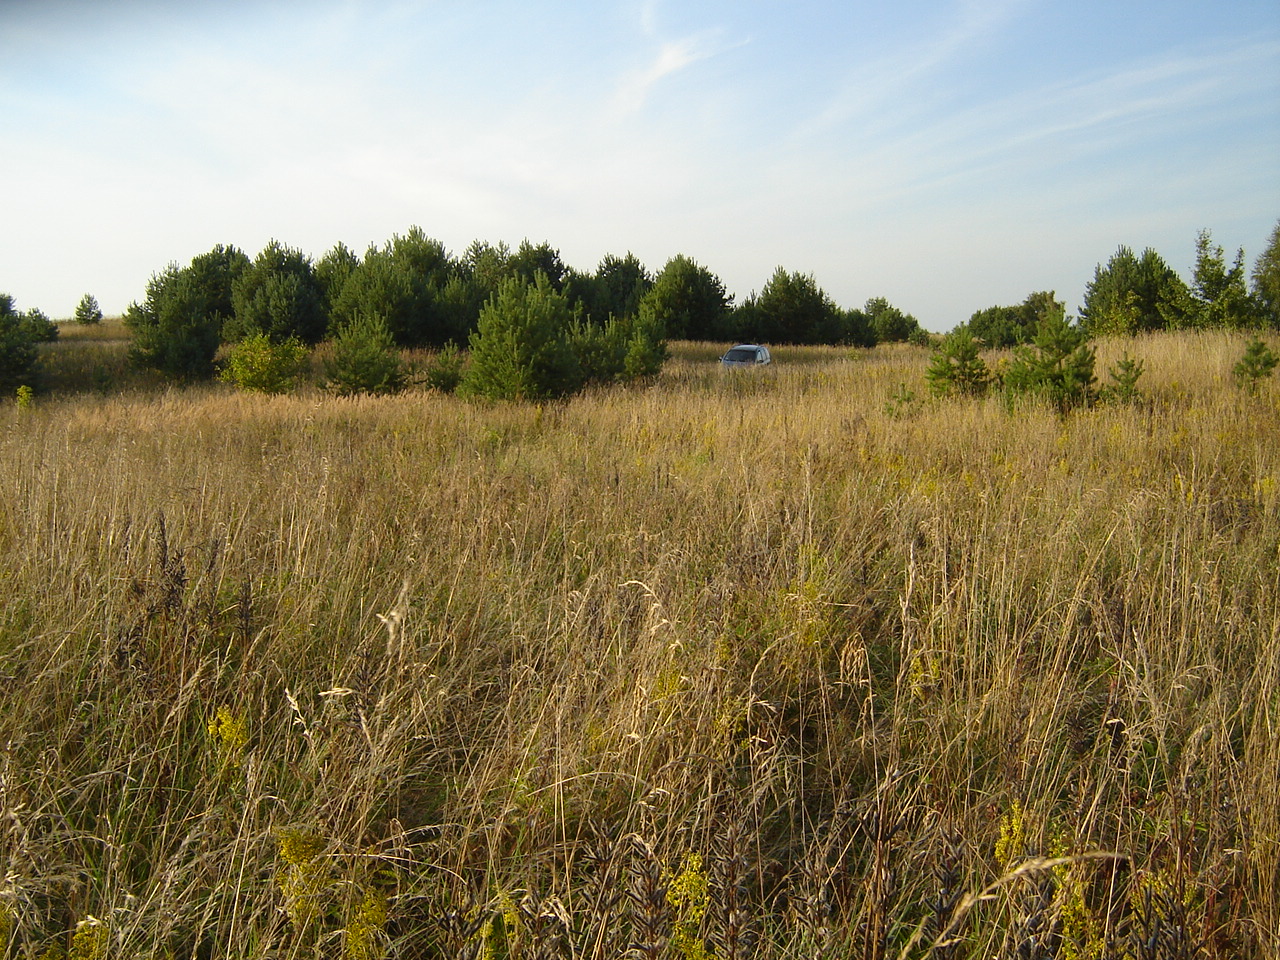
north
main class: Grassland
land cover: Grassland with sparse tree/shrub cover
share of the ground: > 75 %
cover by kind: herbaceous plants 95 %, coniferous forest trees 5 %
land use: Fallow land
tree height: < 5 m
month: August
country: LT
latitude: 54.7374
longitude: 24.9456
